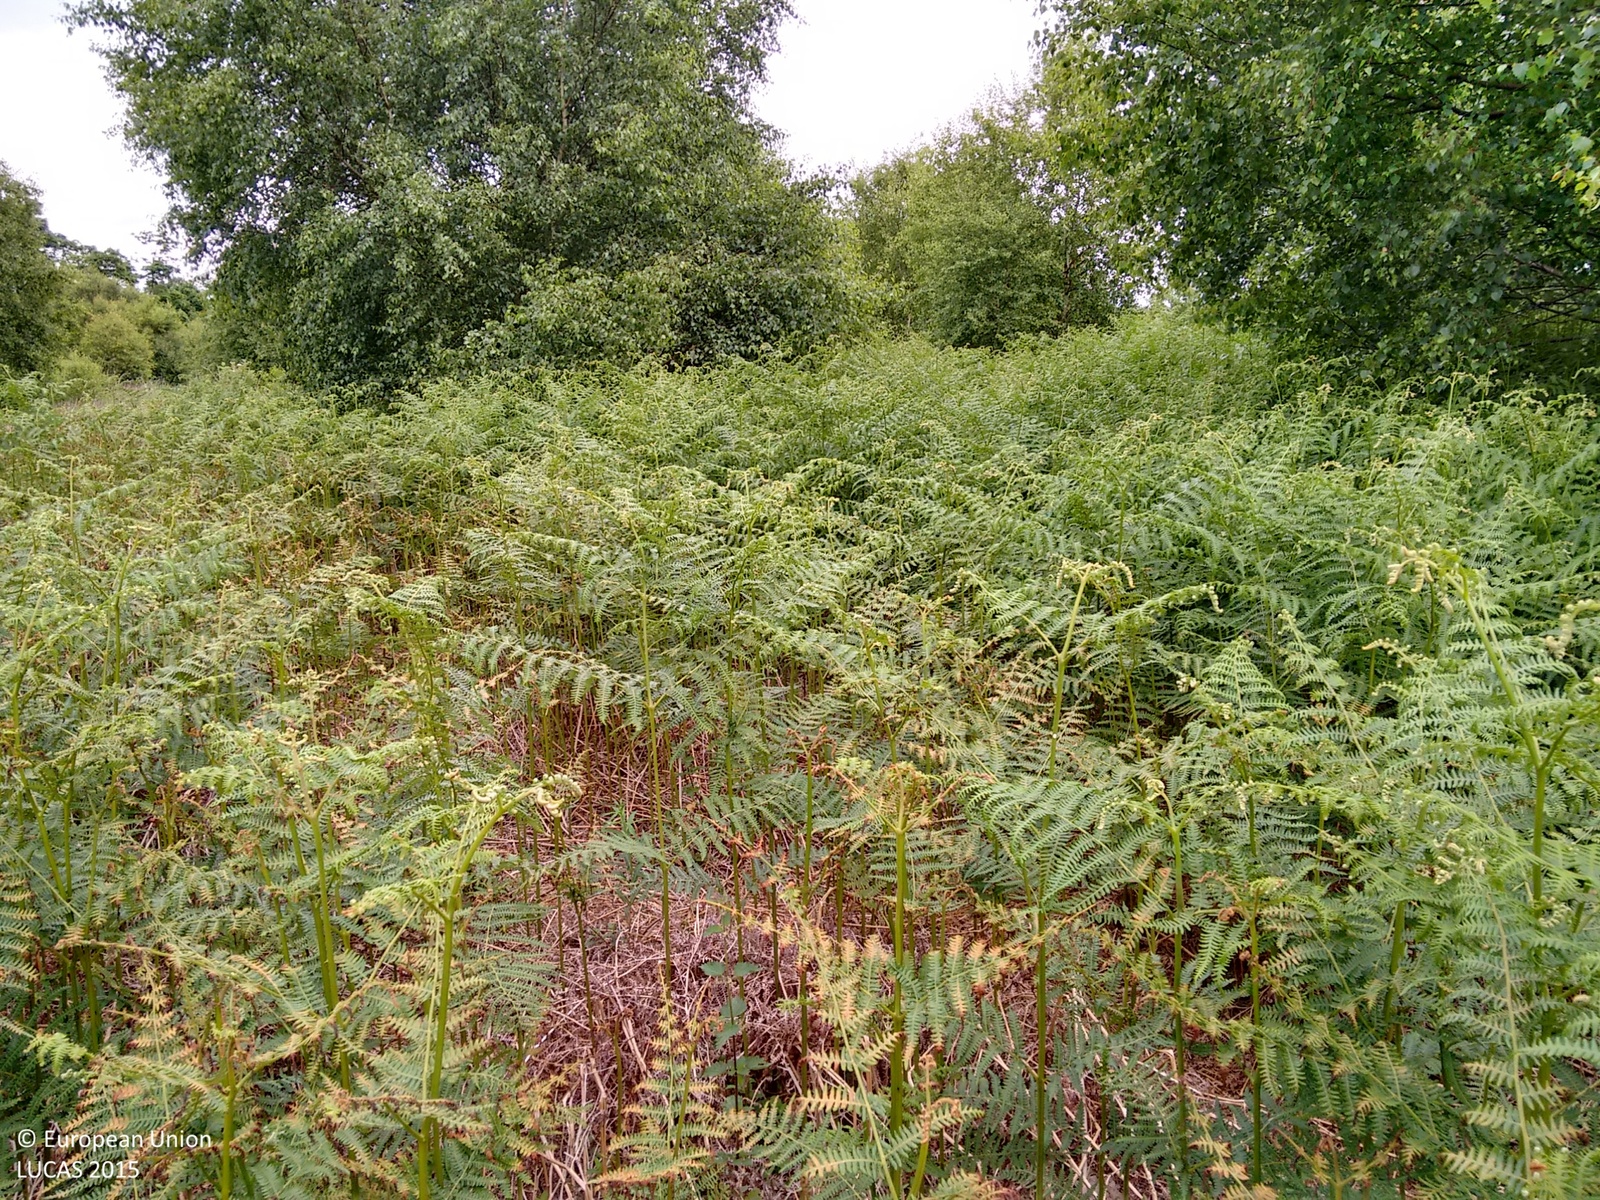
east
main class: Grassland
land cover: Grassland with sparse tree/shrub cover
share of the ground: > 75 %
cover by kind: herbaceous plants 95 %, broadleaved forest trees 5 %
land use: Semi-natural and natural areas not in use
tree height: < 5 m
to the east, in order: Grassland with sparse tree/shrub cover; Broadleaved woodland; Tracks; Grassland with sparse tree/shrub cover; Broadleaved woodland
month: June
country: GB
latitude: 53.5043
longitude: -0.7296
